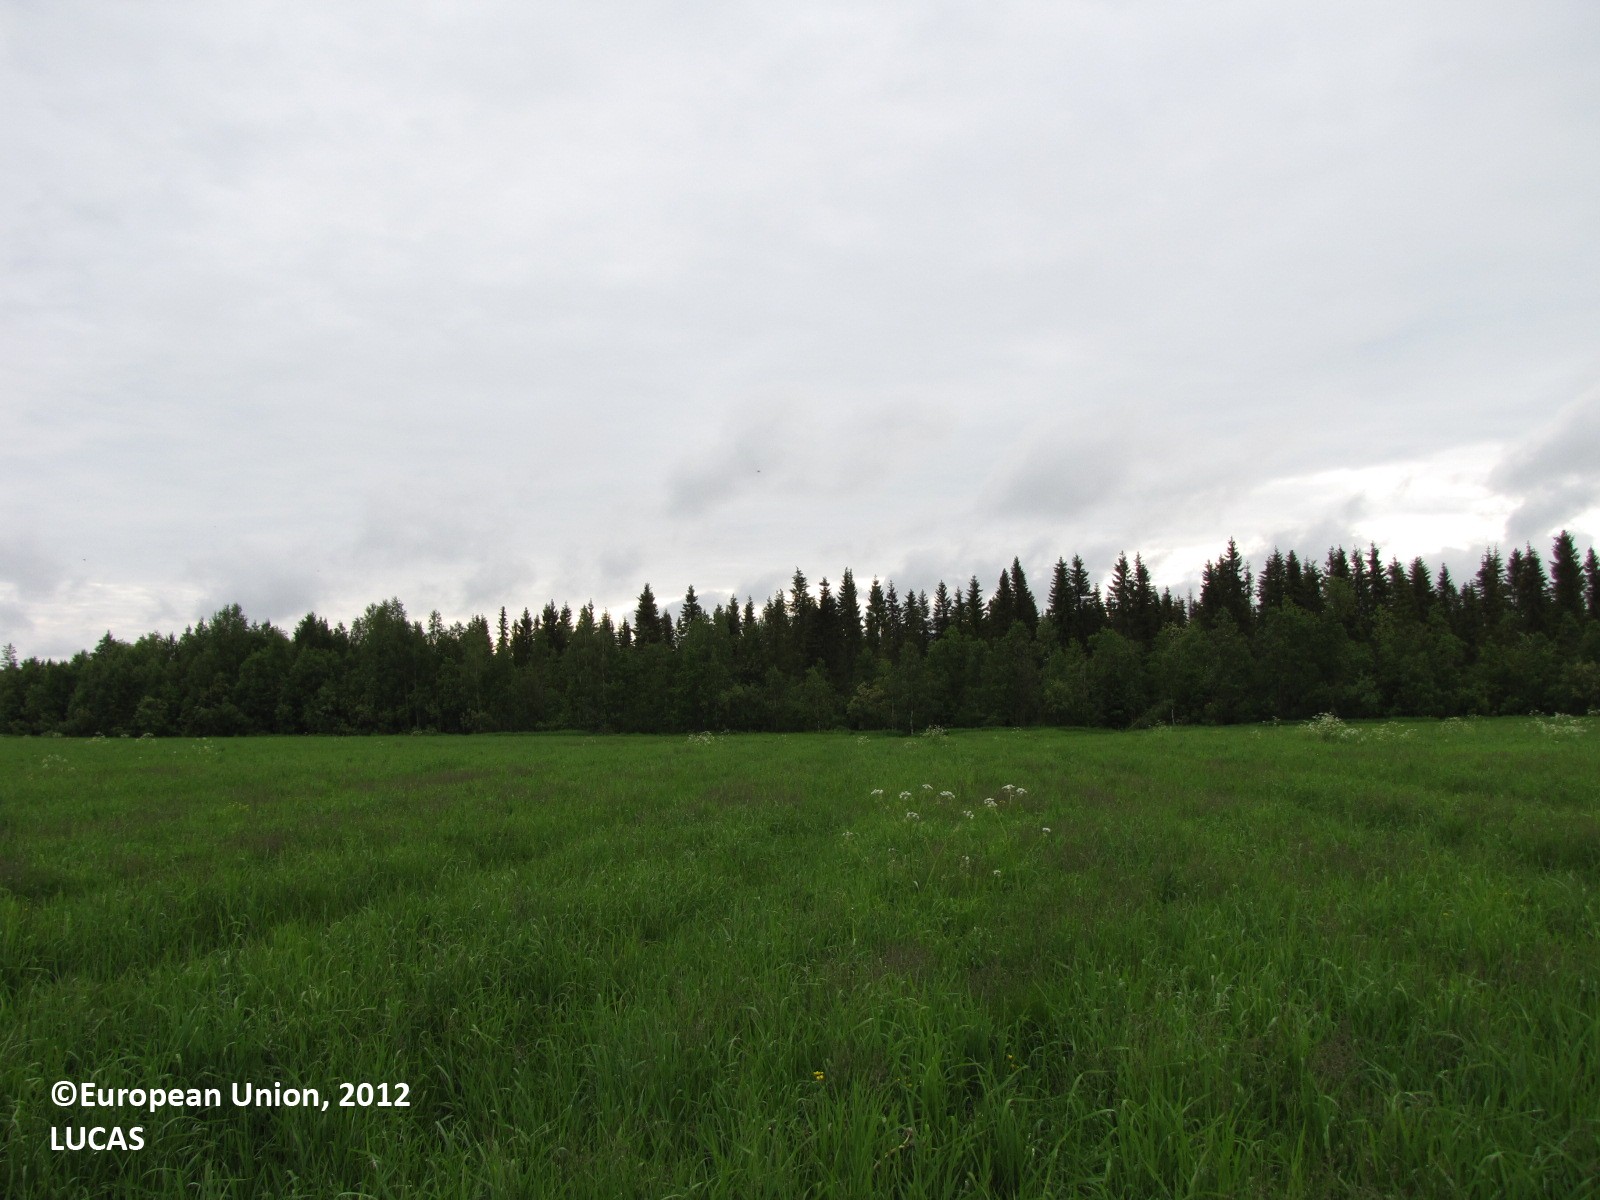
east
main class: Grassland
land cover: Grassland without tree/shrub cover
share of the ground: > 75 %
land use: Agriculture (excluding fallow land and kitchen gardens)
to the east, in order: Grassland without tree/shrub cover; Lines of trees; Ditches and canals; Grass margins; Spruce dominated mixed woodland
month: June
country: FI
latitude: 66.1630
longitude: 24.7104
